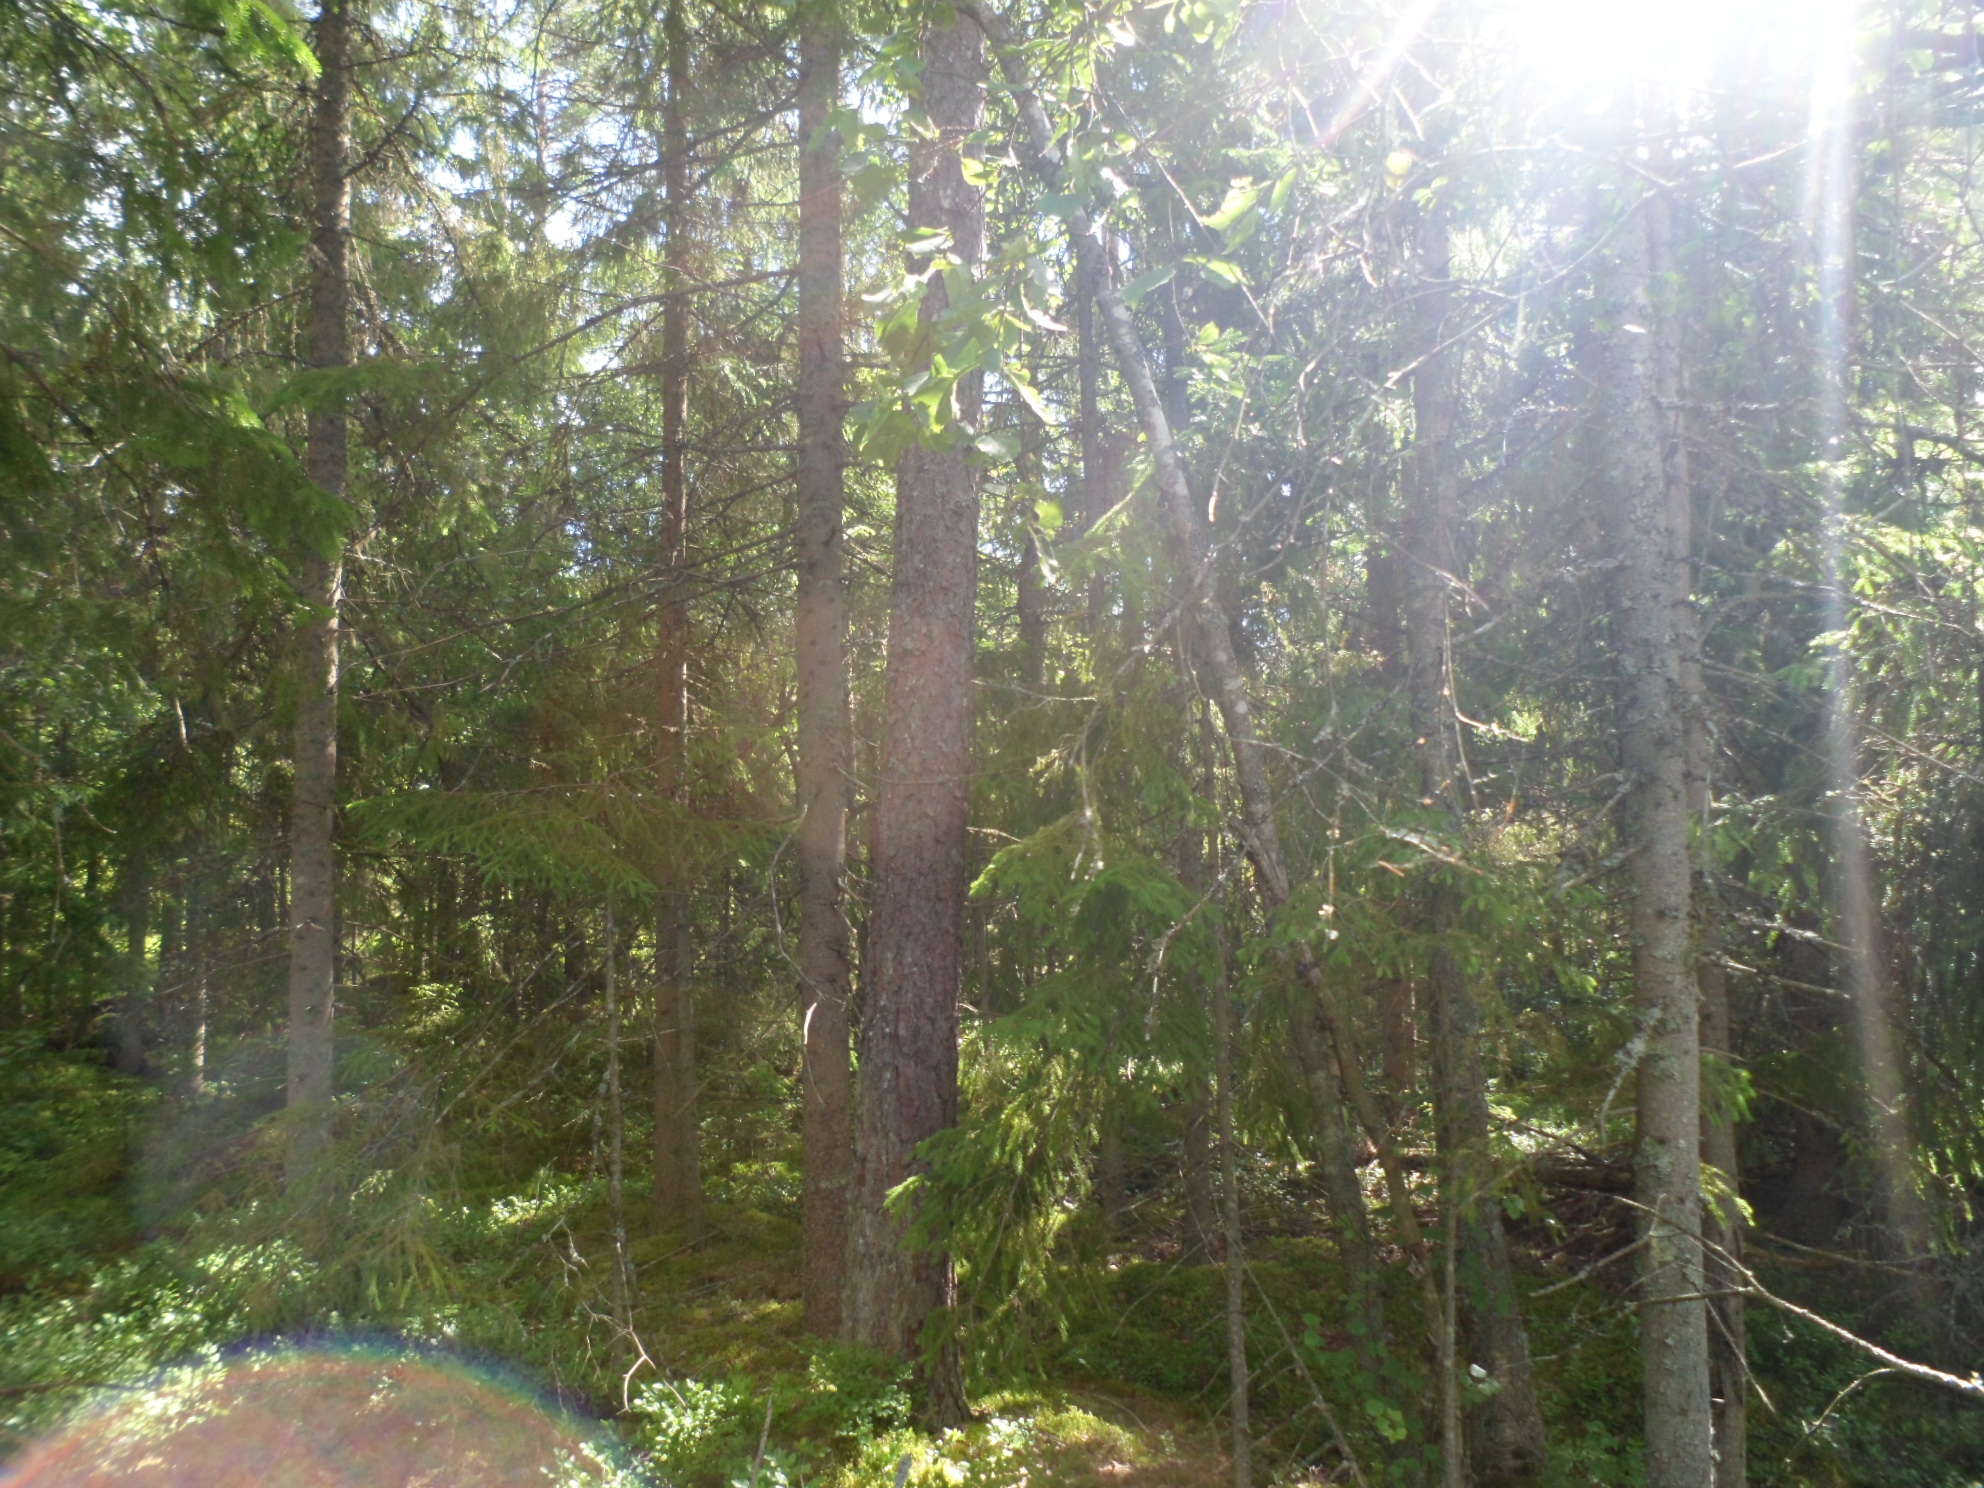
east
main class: Woodland
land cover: Spruce dominated mixed woodland
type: boreal forest
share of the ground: 50 - 75 %
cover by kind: coniferous forest trees 30 %, broadleaved forest trees 25 %, shrubs 25 %, lichens and mosses 15 %, herbaceous plants 5 %
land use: Forestry
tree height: > 5 m
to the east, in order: Spruce dominated mixed woodland; Spruce dominated coniferous woodland; Rivers and streams; Spruce dominated coniferous woodland; Spruce dominated mixed woodland; Tracks; Spruce dominated coniferous woodland; Ditches and canals; Spruce dominated coniferous woodland; Spruce dominated mixed woodland; Tracks; Spruce dominated mixed woodland; Shrubland with sparse tree cover
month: June
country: SE
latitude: 57.1569
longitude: 14.9068
